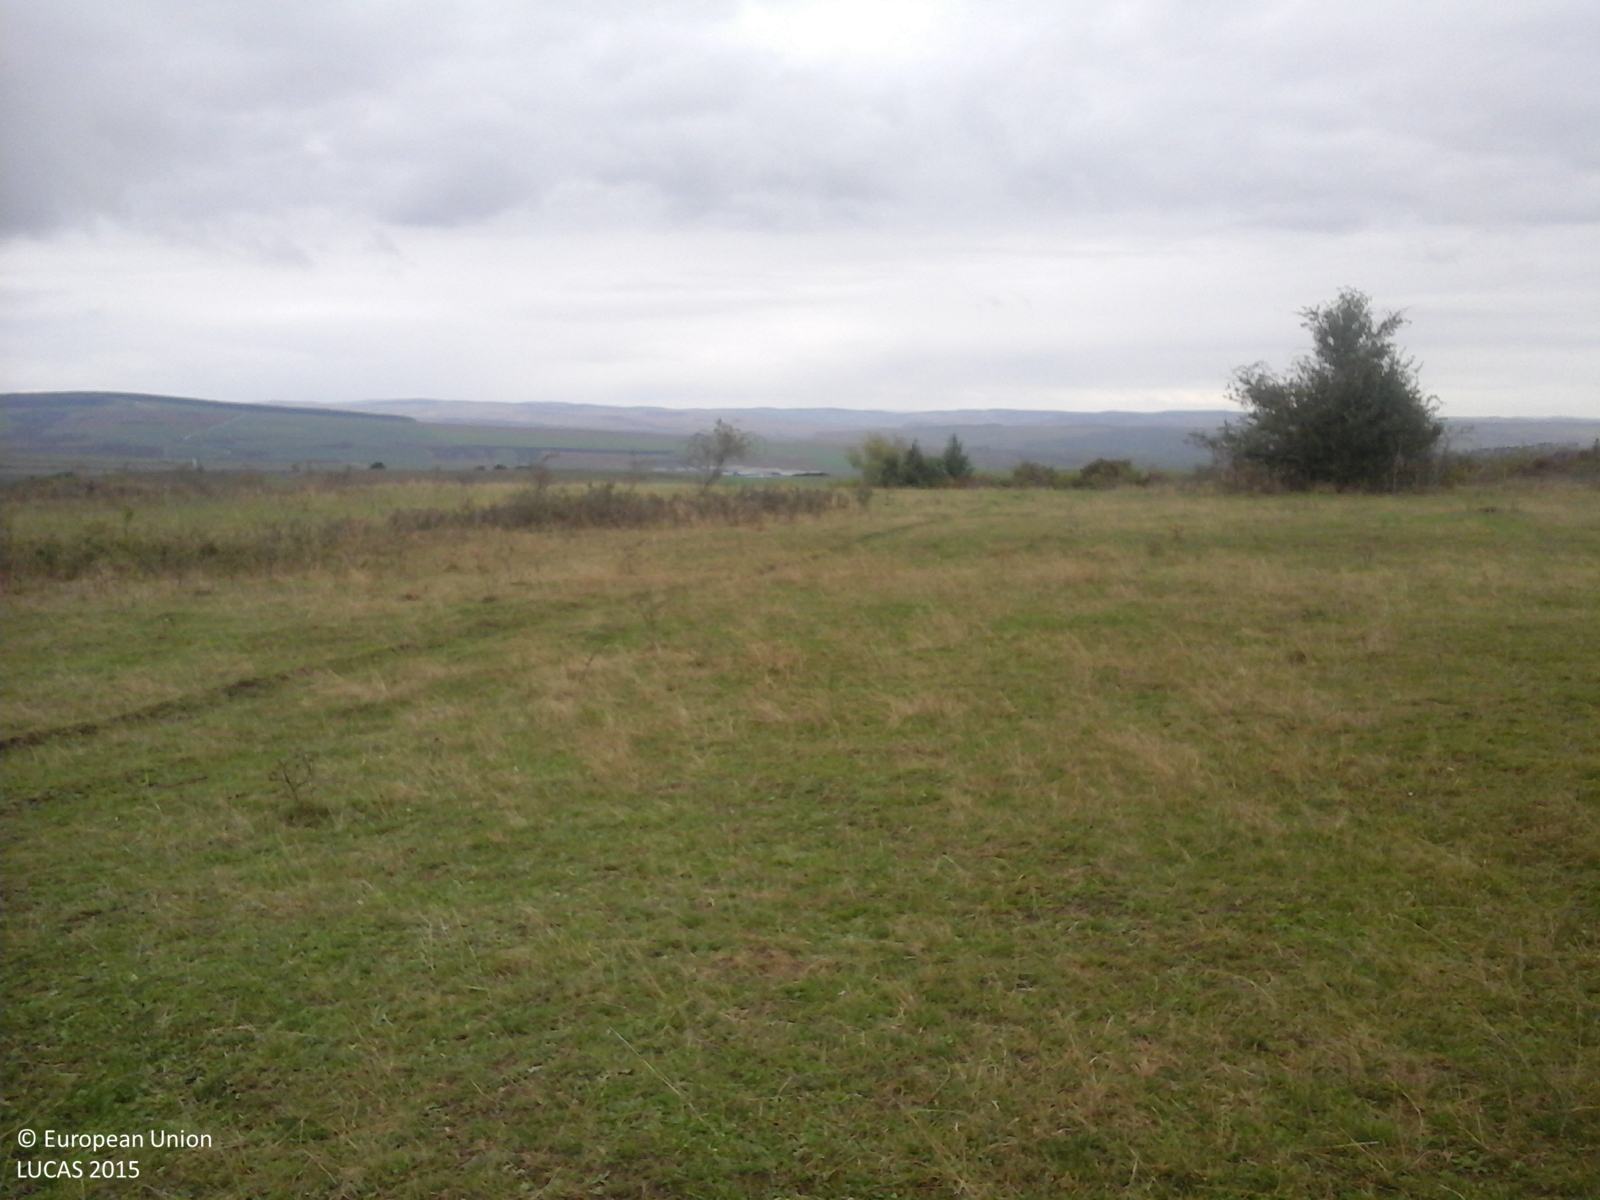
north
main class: Grassland
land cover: Grassland with sparse tree/shrub cover
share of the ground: > 75 %
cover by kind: herbaceous plants 85 %, shrubs 10 %, broadleaved forest trees 5 %
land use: Agriculture (excluding fallow land and kitchen gardens)
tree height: < 5 m
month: September
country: RO
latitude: 45.8443
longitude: 23.7293
